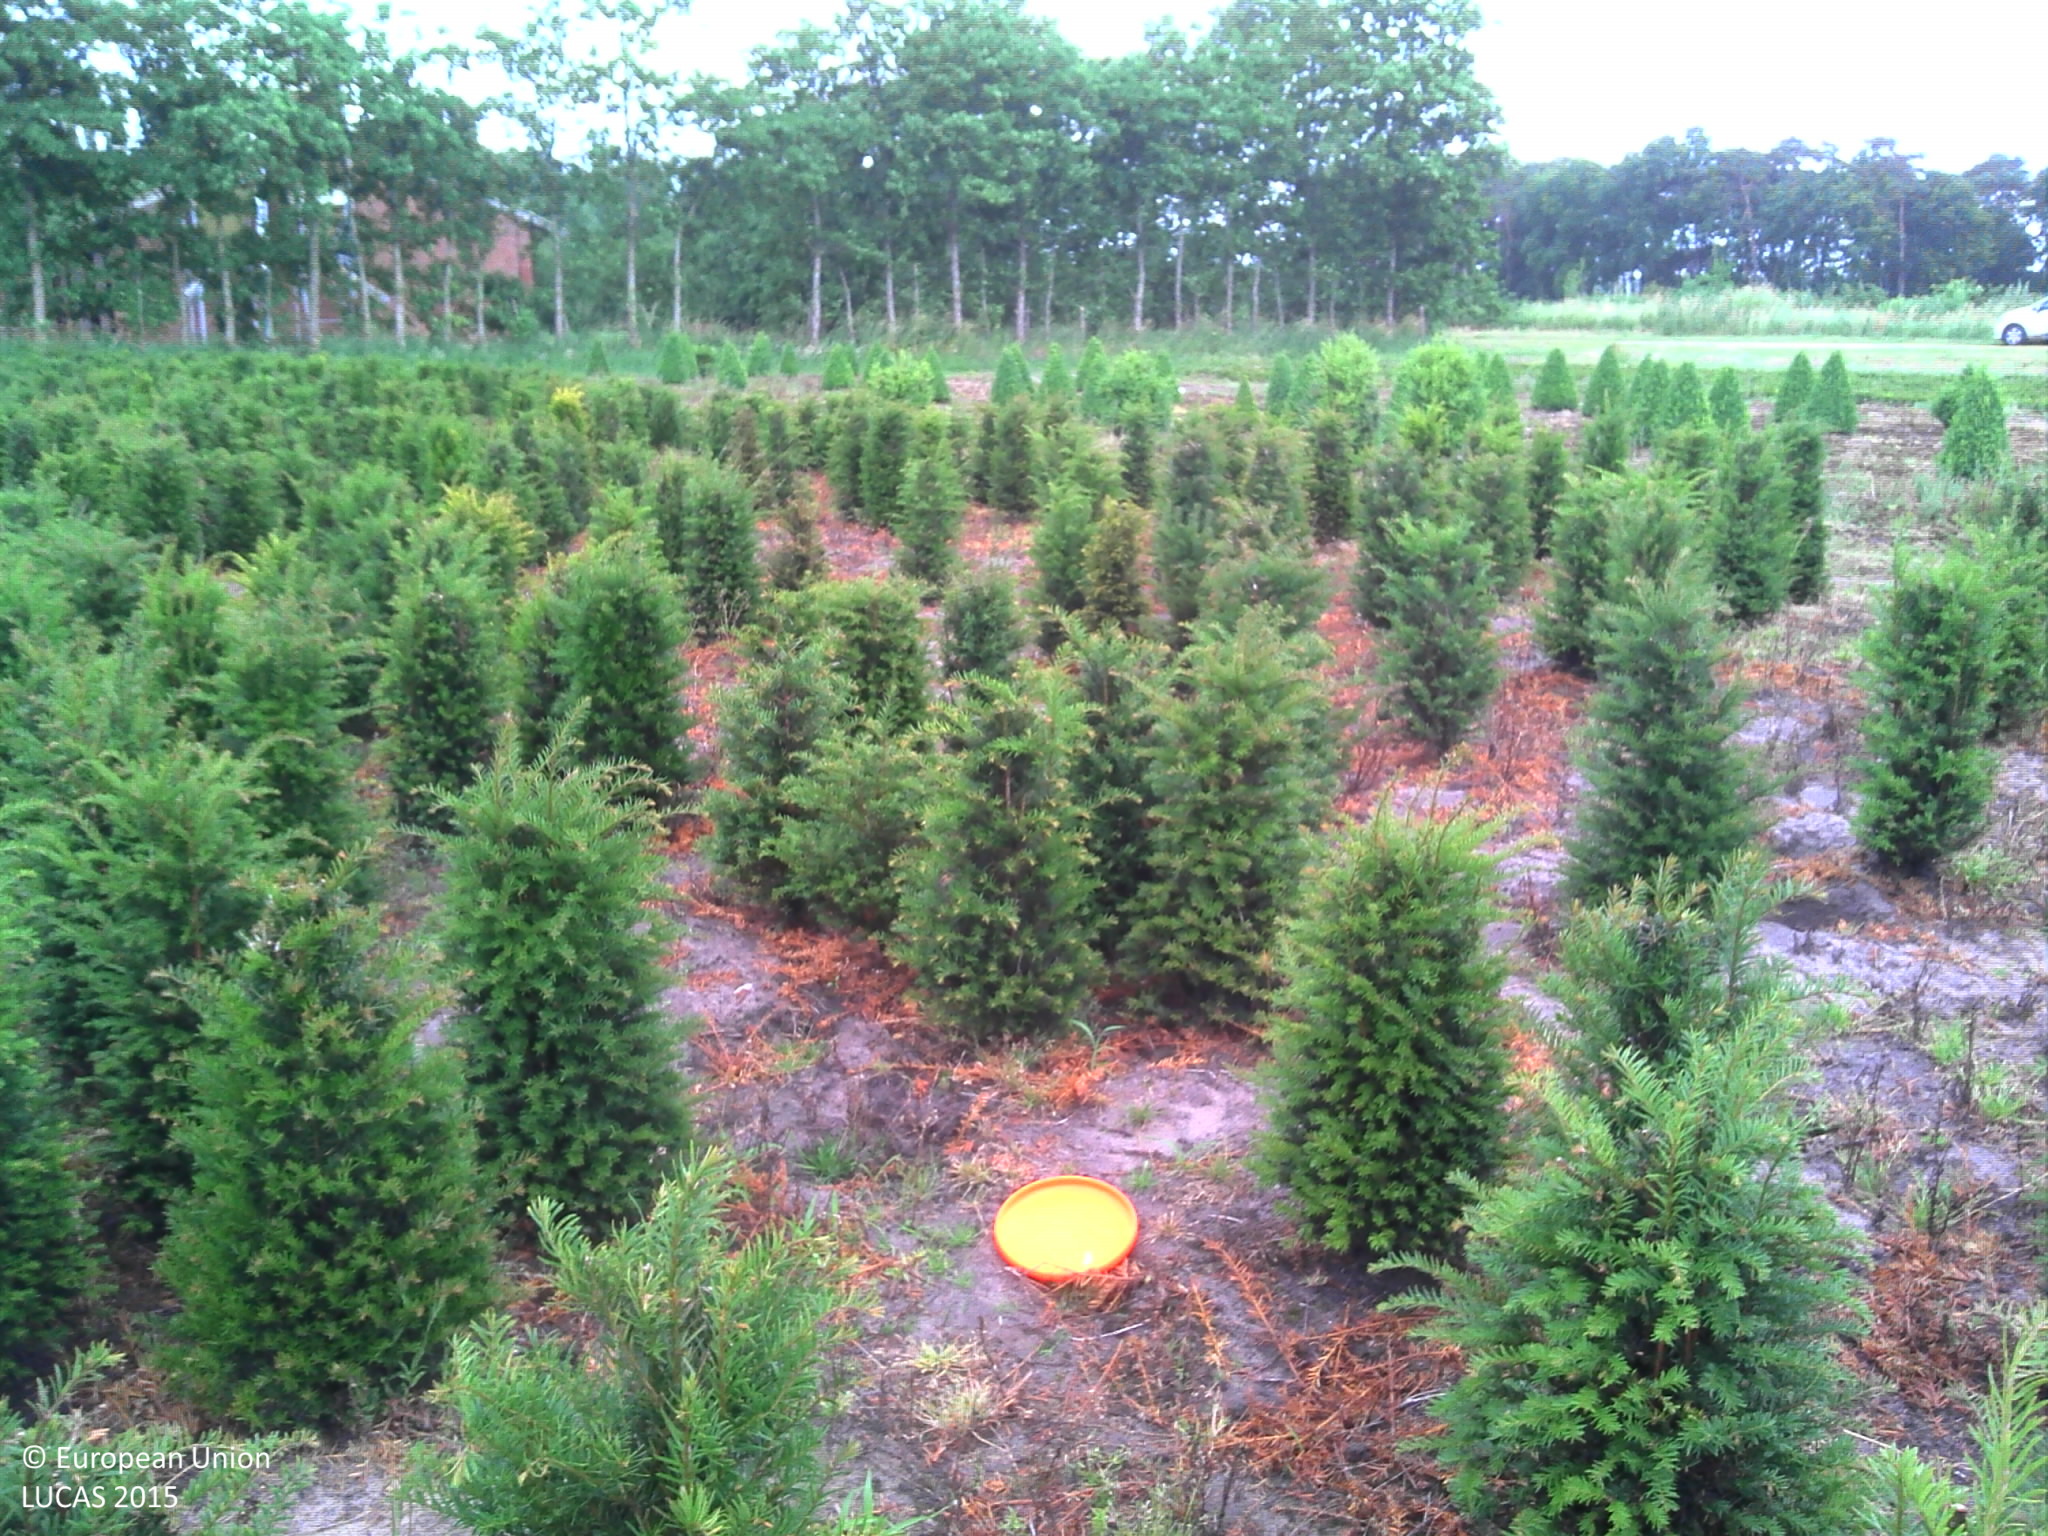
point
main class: Cropland
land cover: Nurseries
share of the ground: > 75 %
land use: Agriculture (excluding fallow land and kitchen gardens)
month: June
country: BE
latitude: 51.2101
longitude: 3.8814
